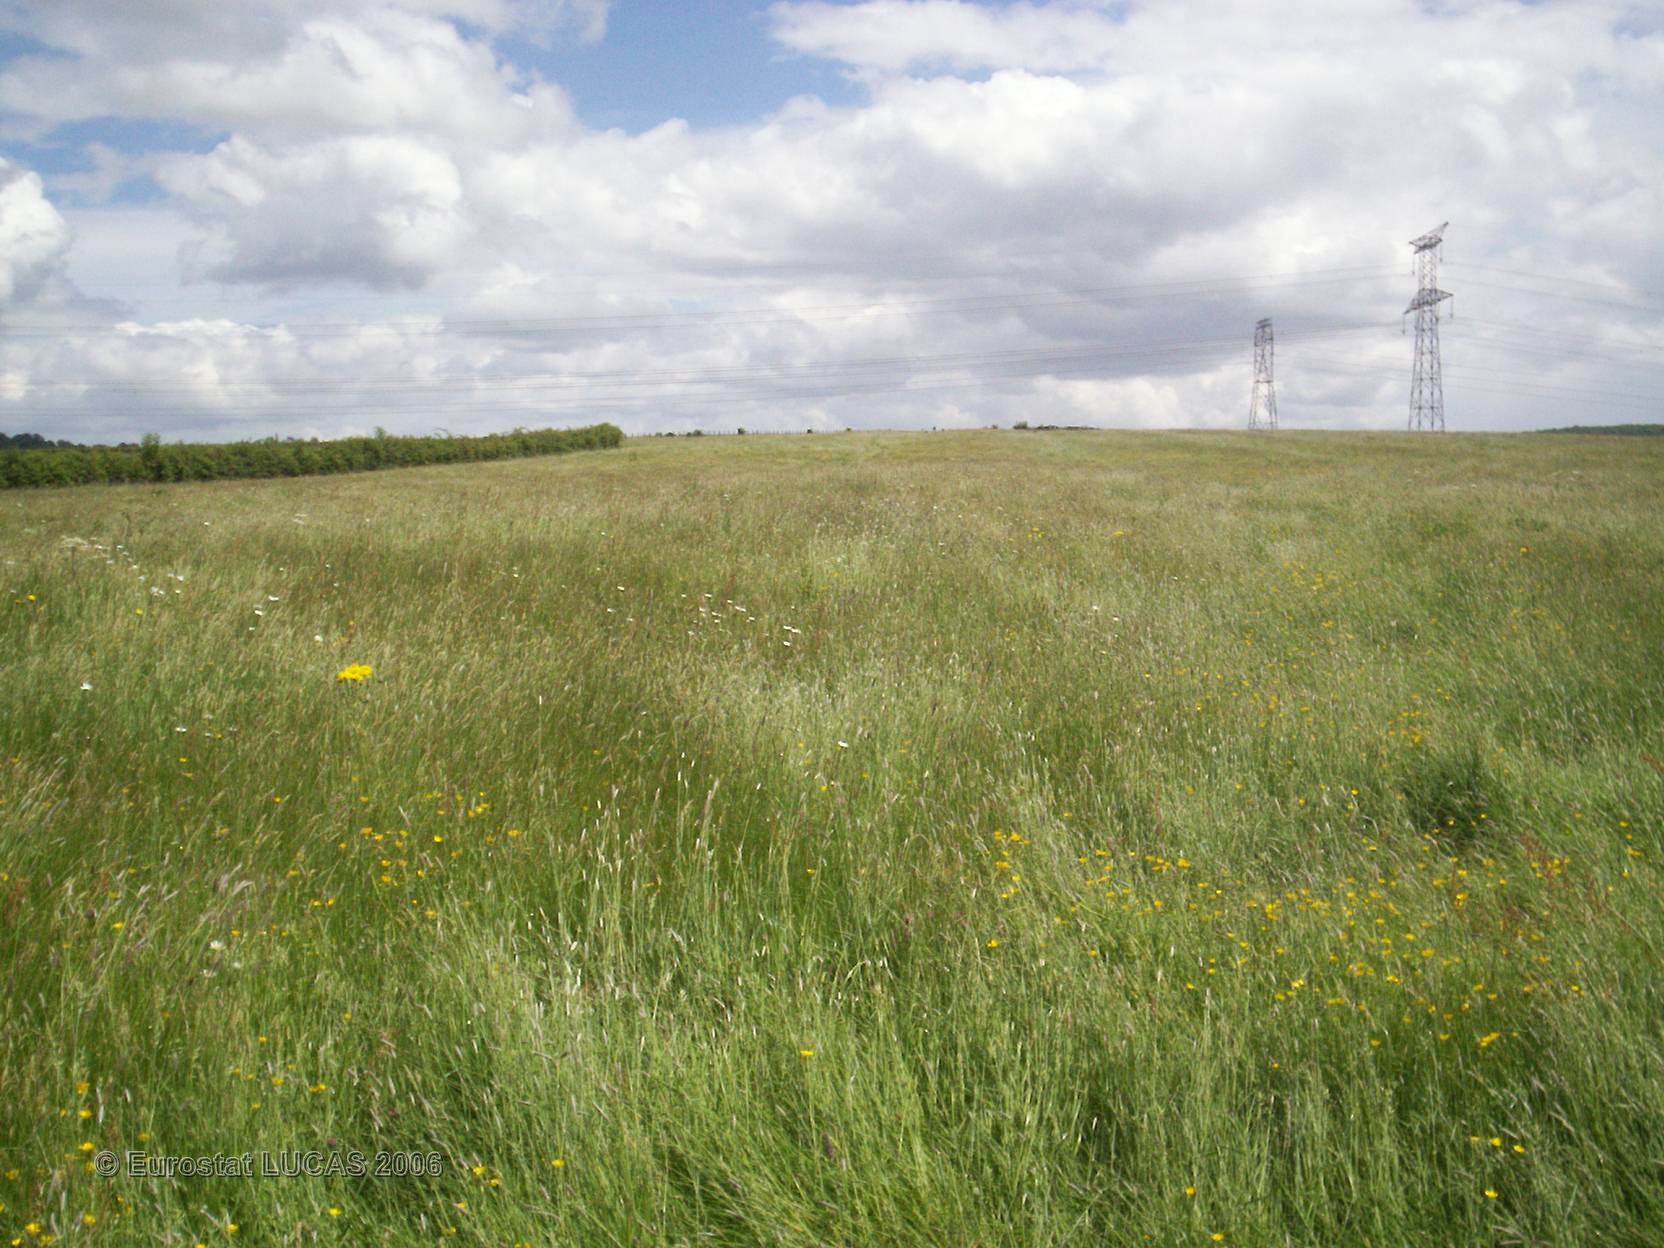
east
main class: Grassland
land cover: Grassland without tree/shrub cover
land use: Agriculture (excluding fallow land and kitchen gardens)
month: May
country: FR
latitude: 47.0638
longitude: 4.6150
